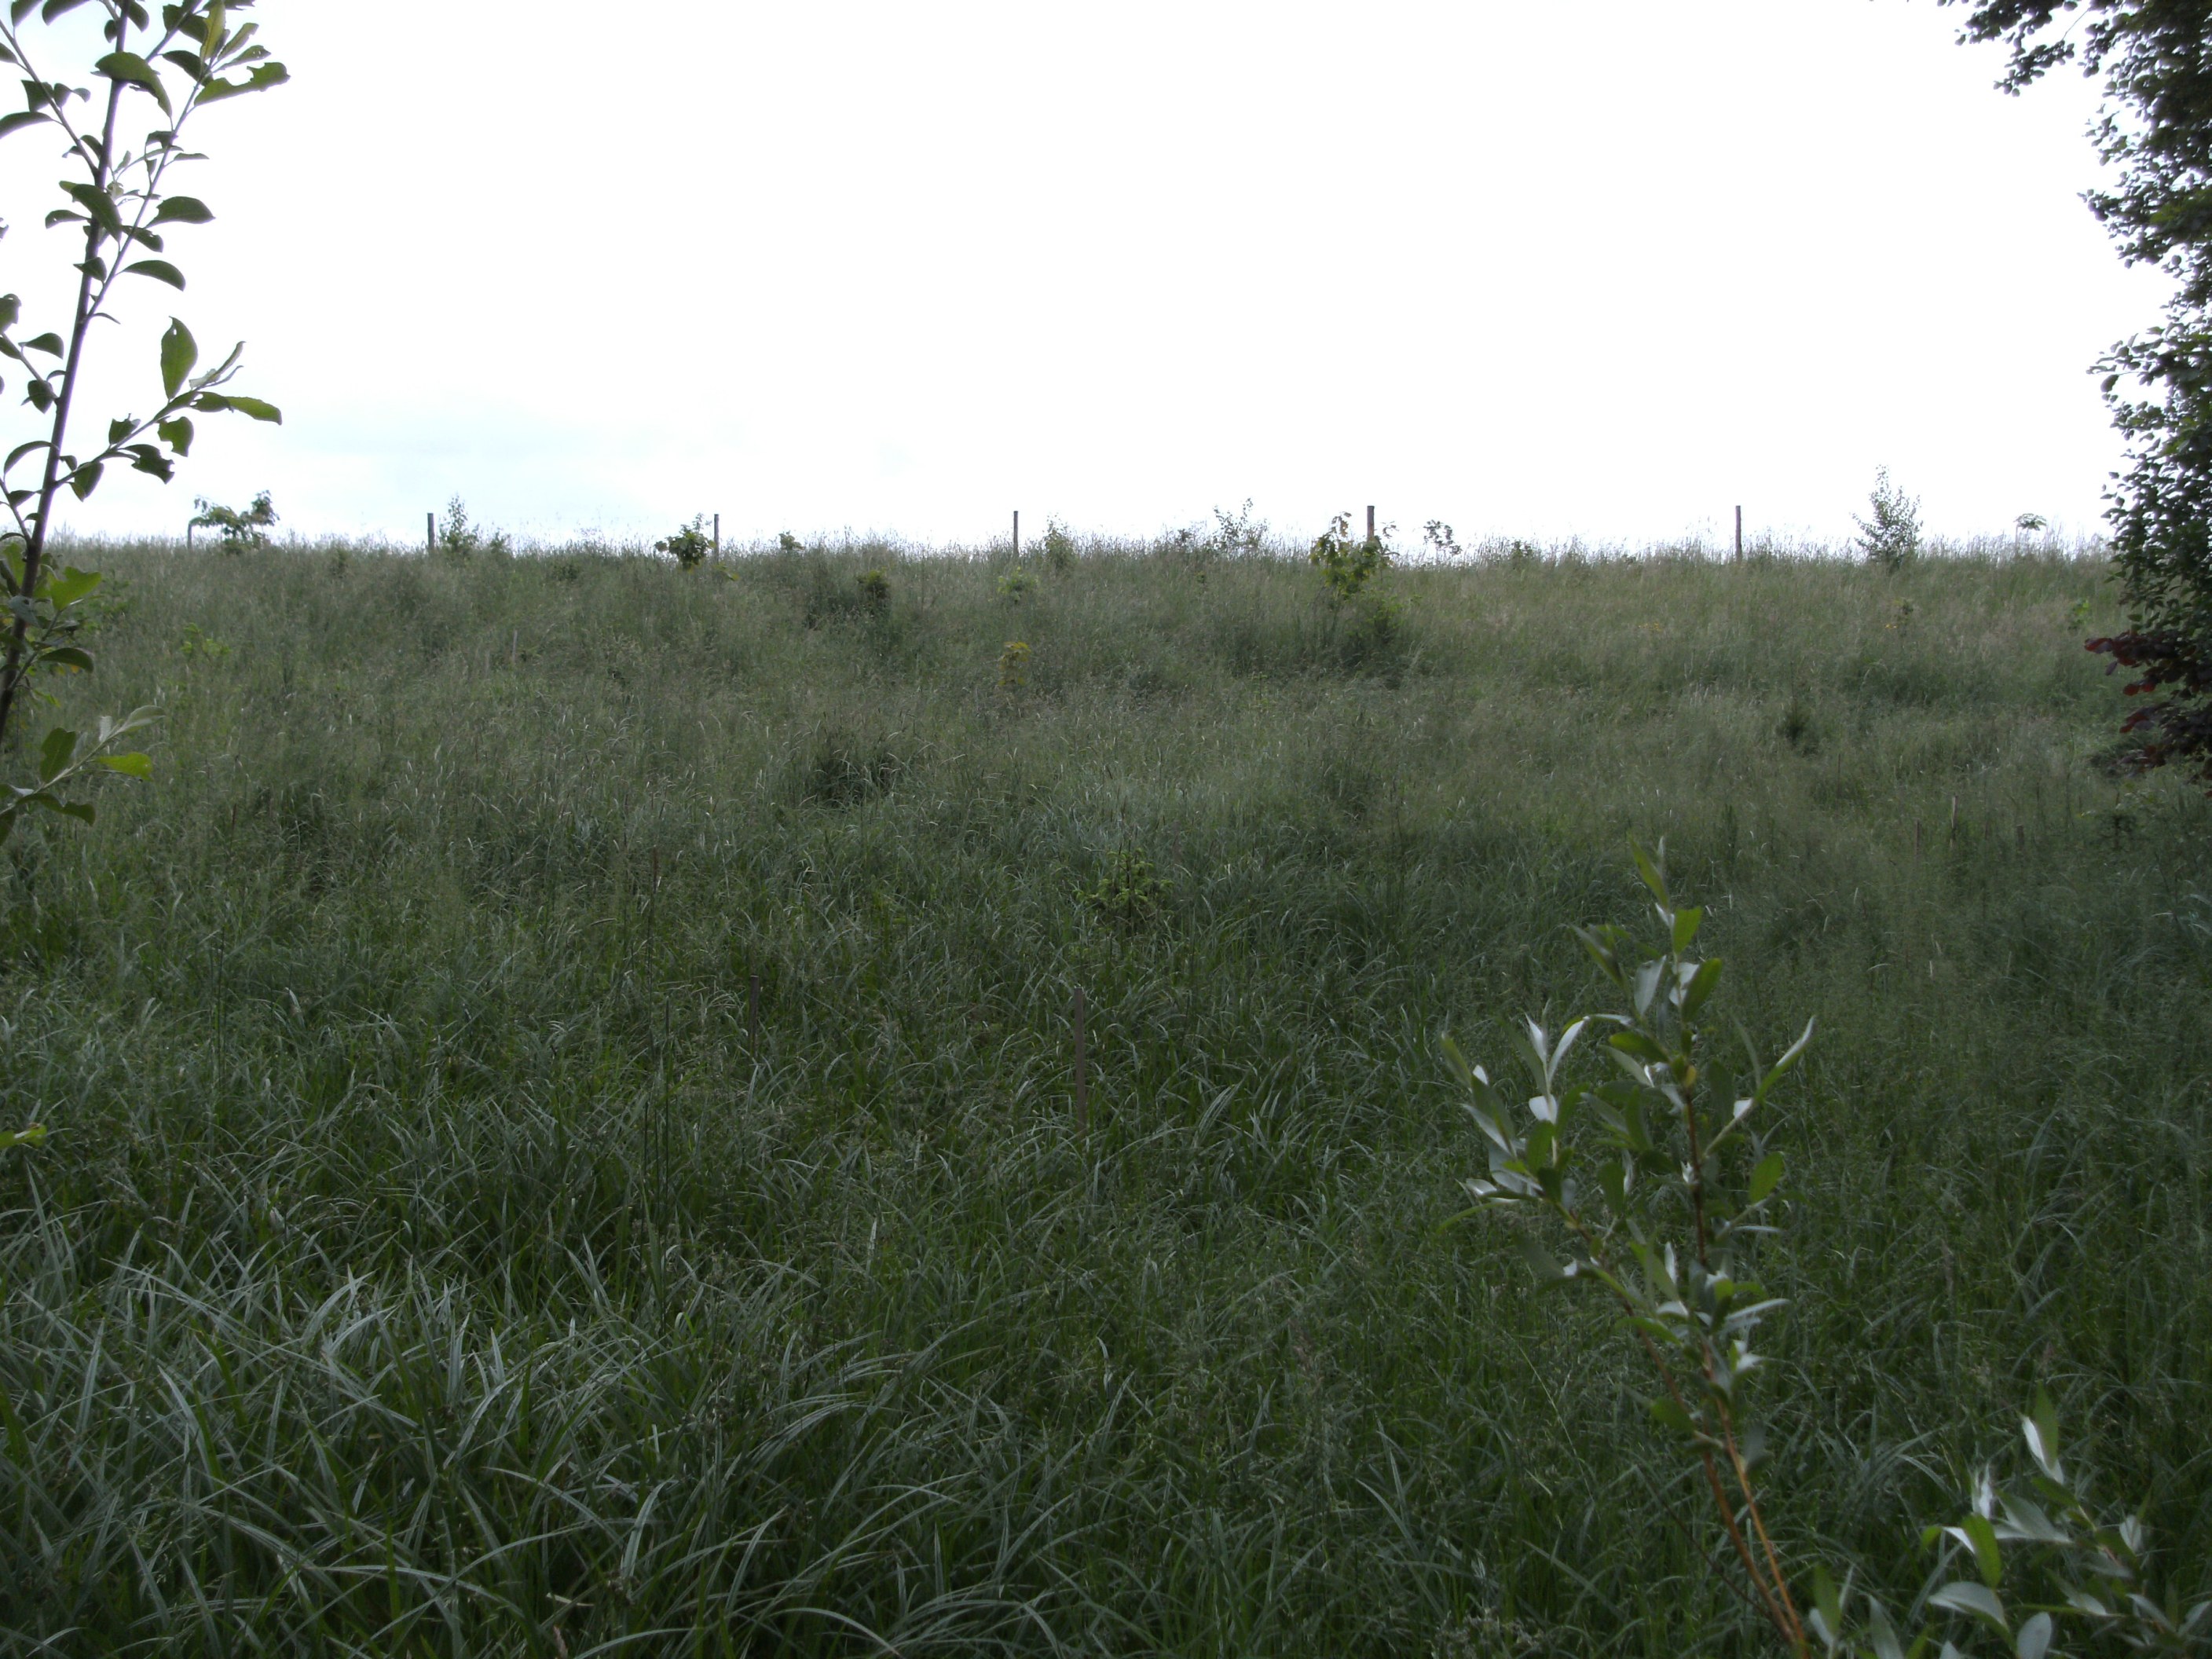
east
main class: Grassland
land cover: Grassland with sparse tree/shrub cover
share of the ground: > 75 %
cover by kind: herbaceous plants 95 %, broadleaved forest trees 5 %
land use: Agriculture (excluding fallow land and kitchen gardens)
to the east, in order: Fences; Grassland with sparse tree/shrub cover; Fences; Grass margins; Maize; Grass margins; Dry pulses; Grass margins; Artificial constructions in urban areas
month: May
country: AT
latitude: 48.1050
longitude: 13.7731
